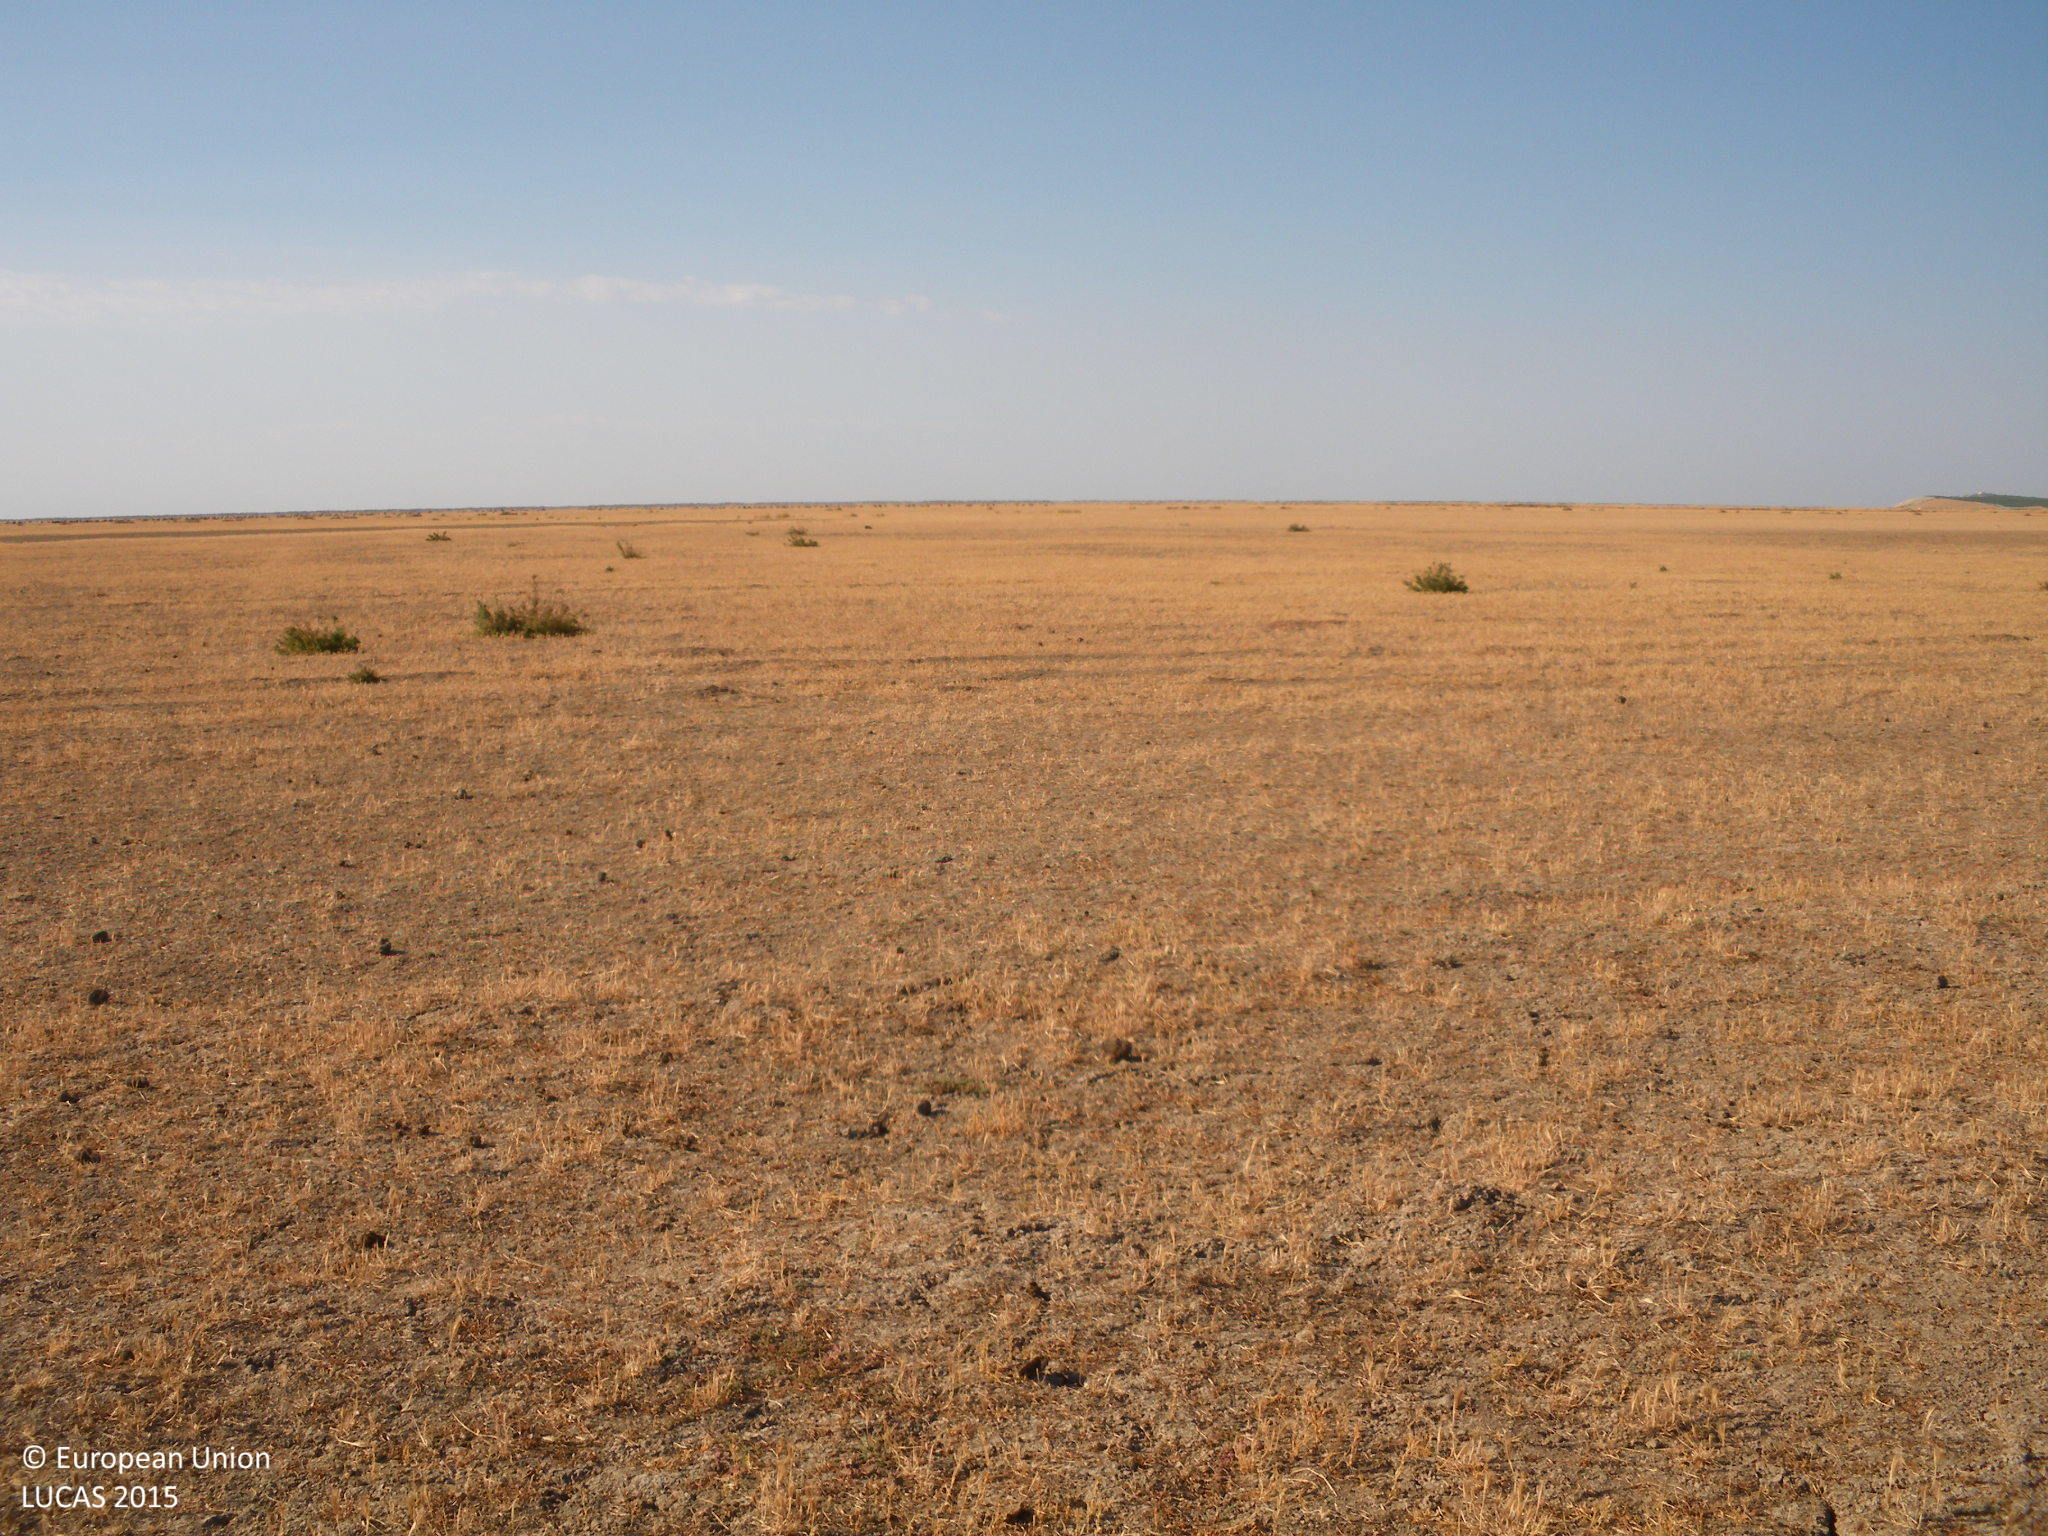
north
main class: Grassland
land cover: Spontaneously vegetated surfaces
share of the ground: > 75 %
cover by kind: herbaceous plants 80 %, unconsolidated bare surface 20 %
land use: Agriculture (excluding fallow land and kitchen gardens)
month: May
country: ES
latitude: 36.8353
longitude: -6.2648
